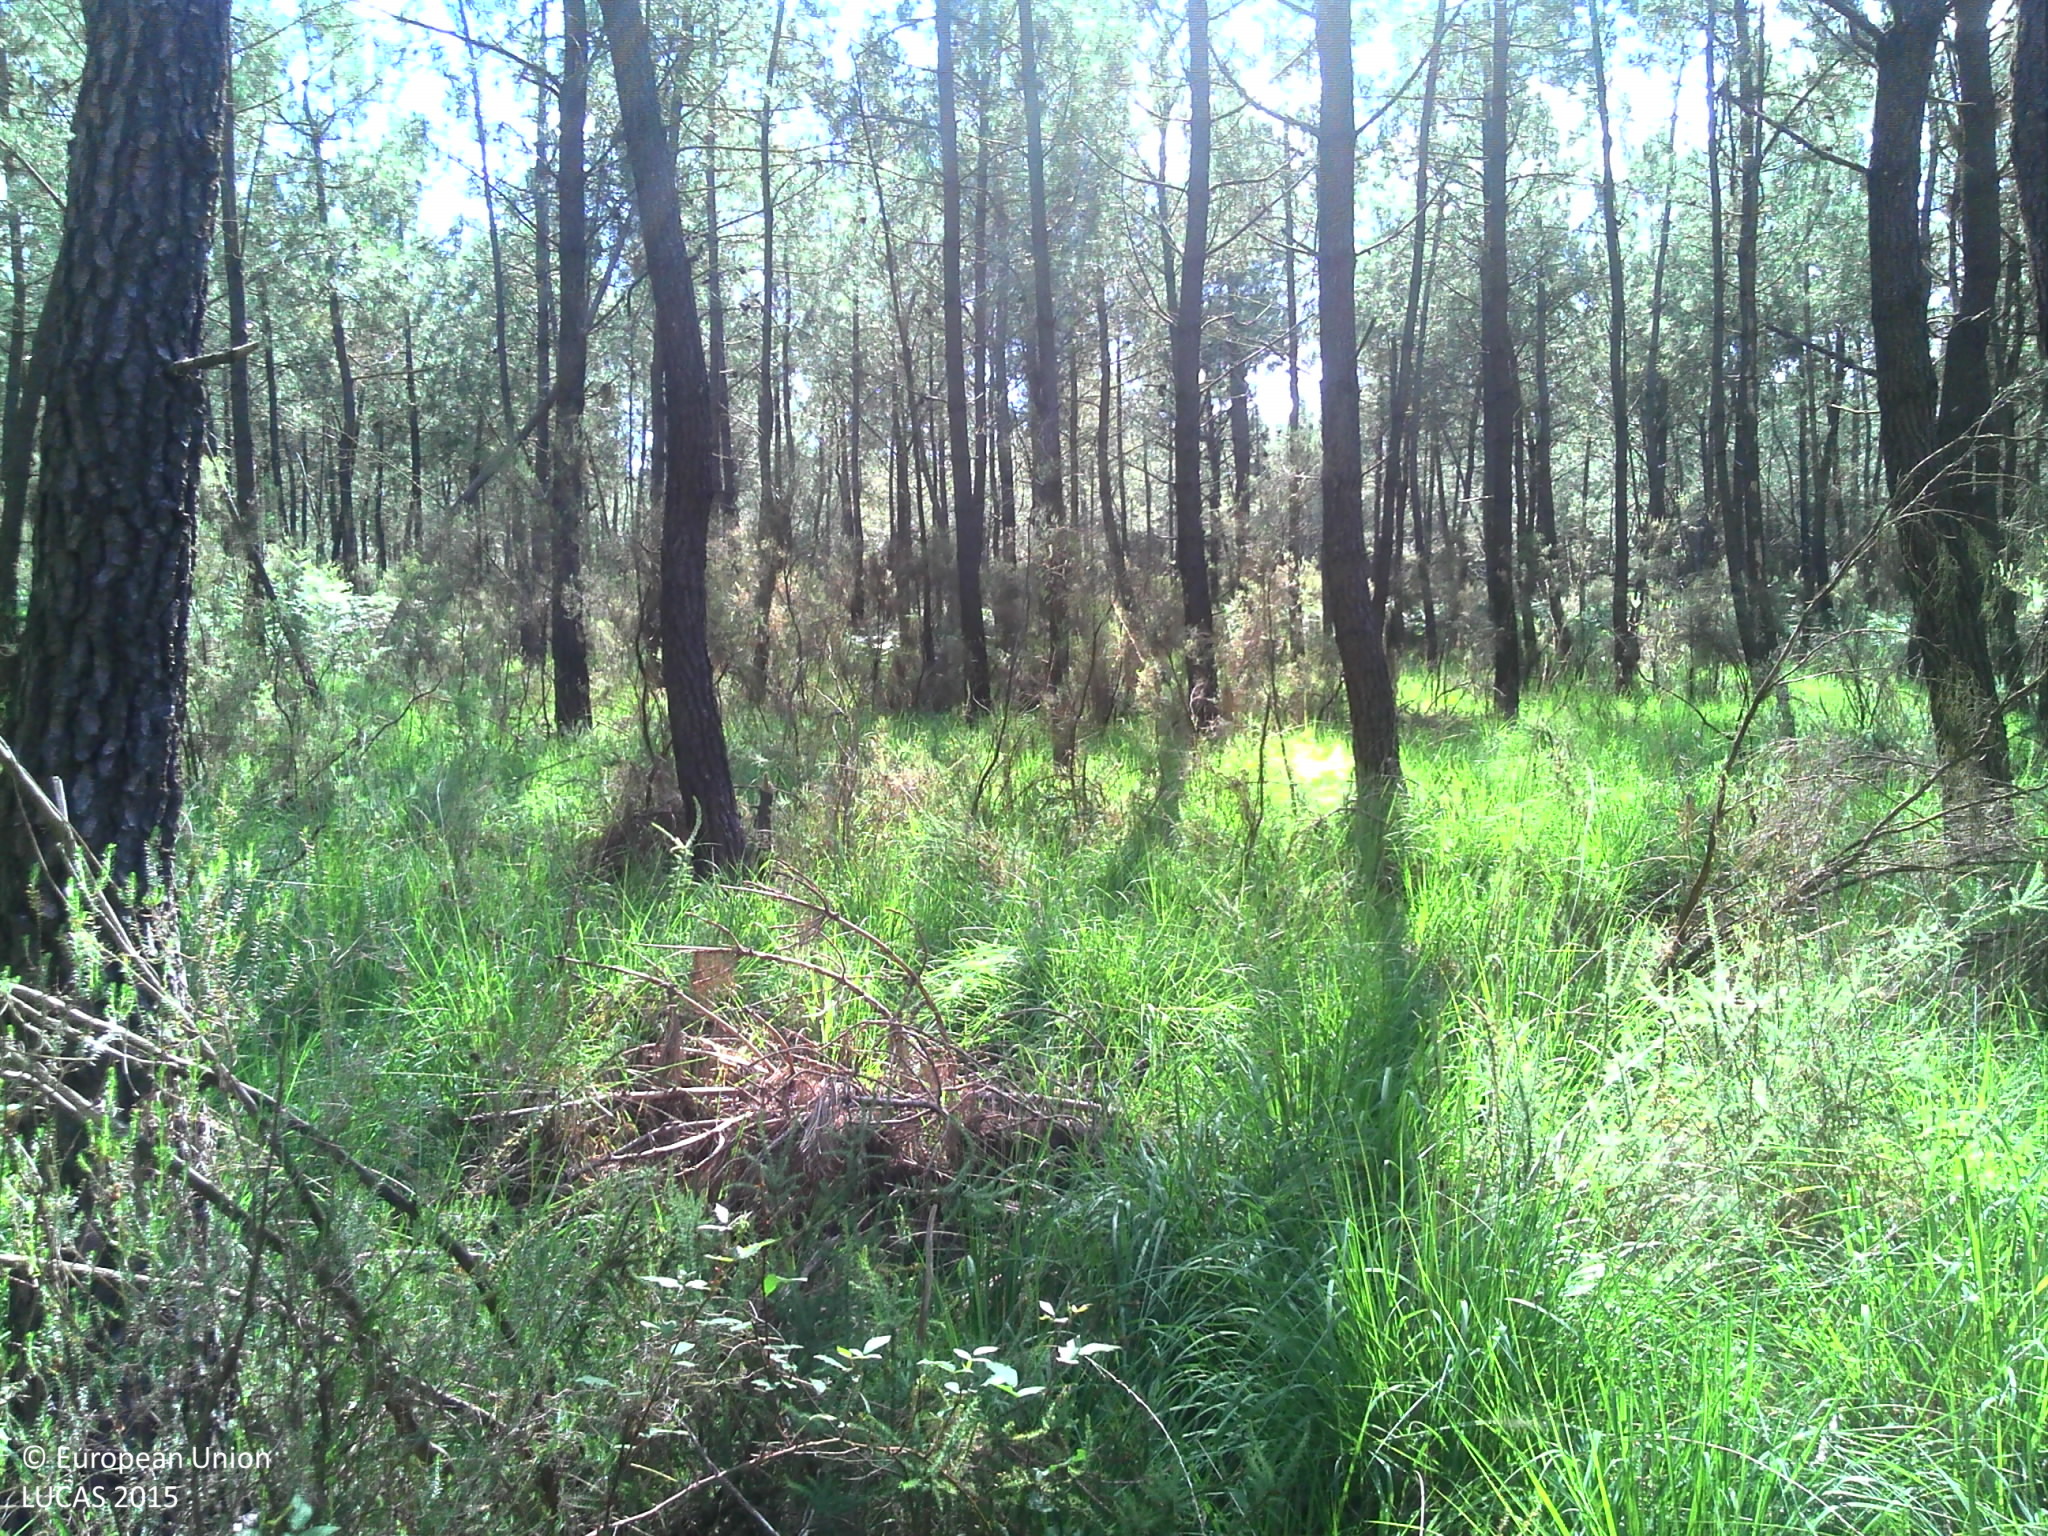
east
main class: Woodland
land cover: Pine dominated coniferous woodland
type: boreal forest
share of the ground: > 75 %
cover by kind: coniferous forest trees 85 %, herbaceous plants 10 %, shrubs 5 %
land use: Forestry
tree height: > 5 m
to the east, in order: Pine dominated coniferous woodland; Ditches and canals; Grass margins; Tracks; Grass margins; Ditches and canals; Pine dominated coniferous woodland
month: June
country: FR
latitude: 46.6891
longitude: 0.5020
